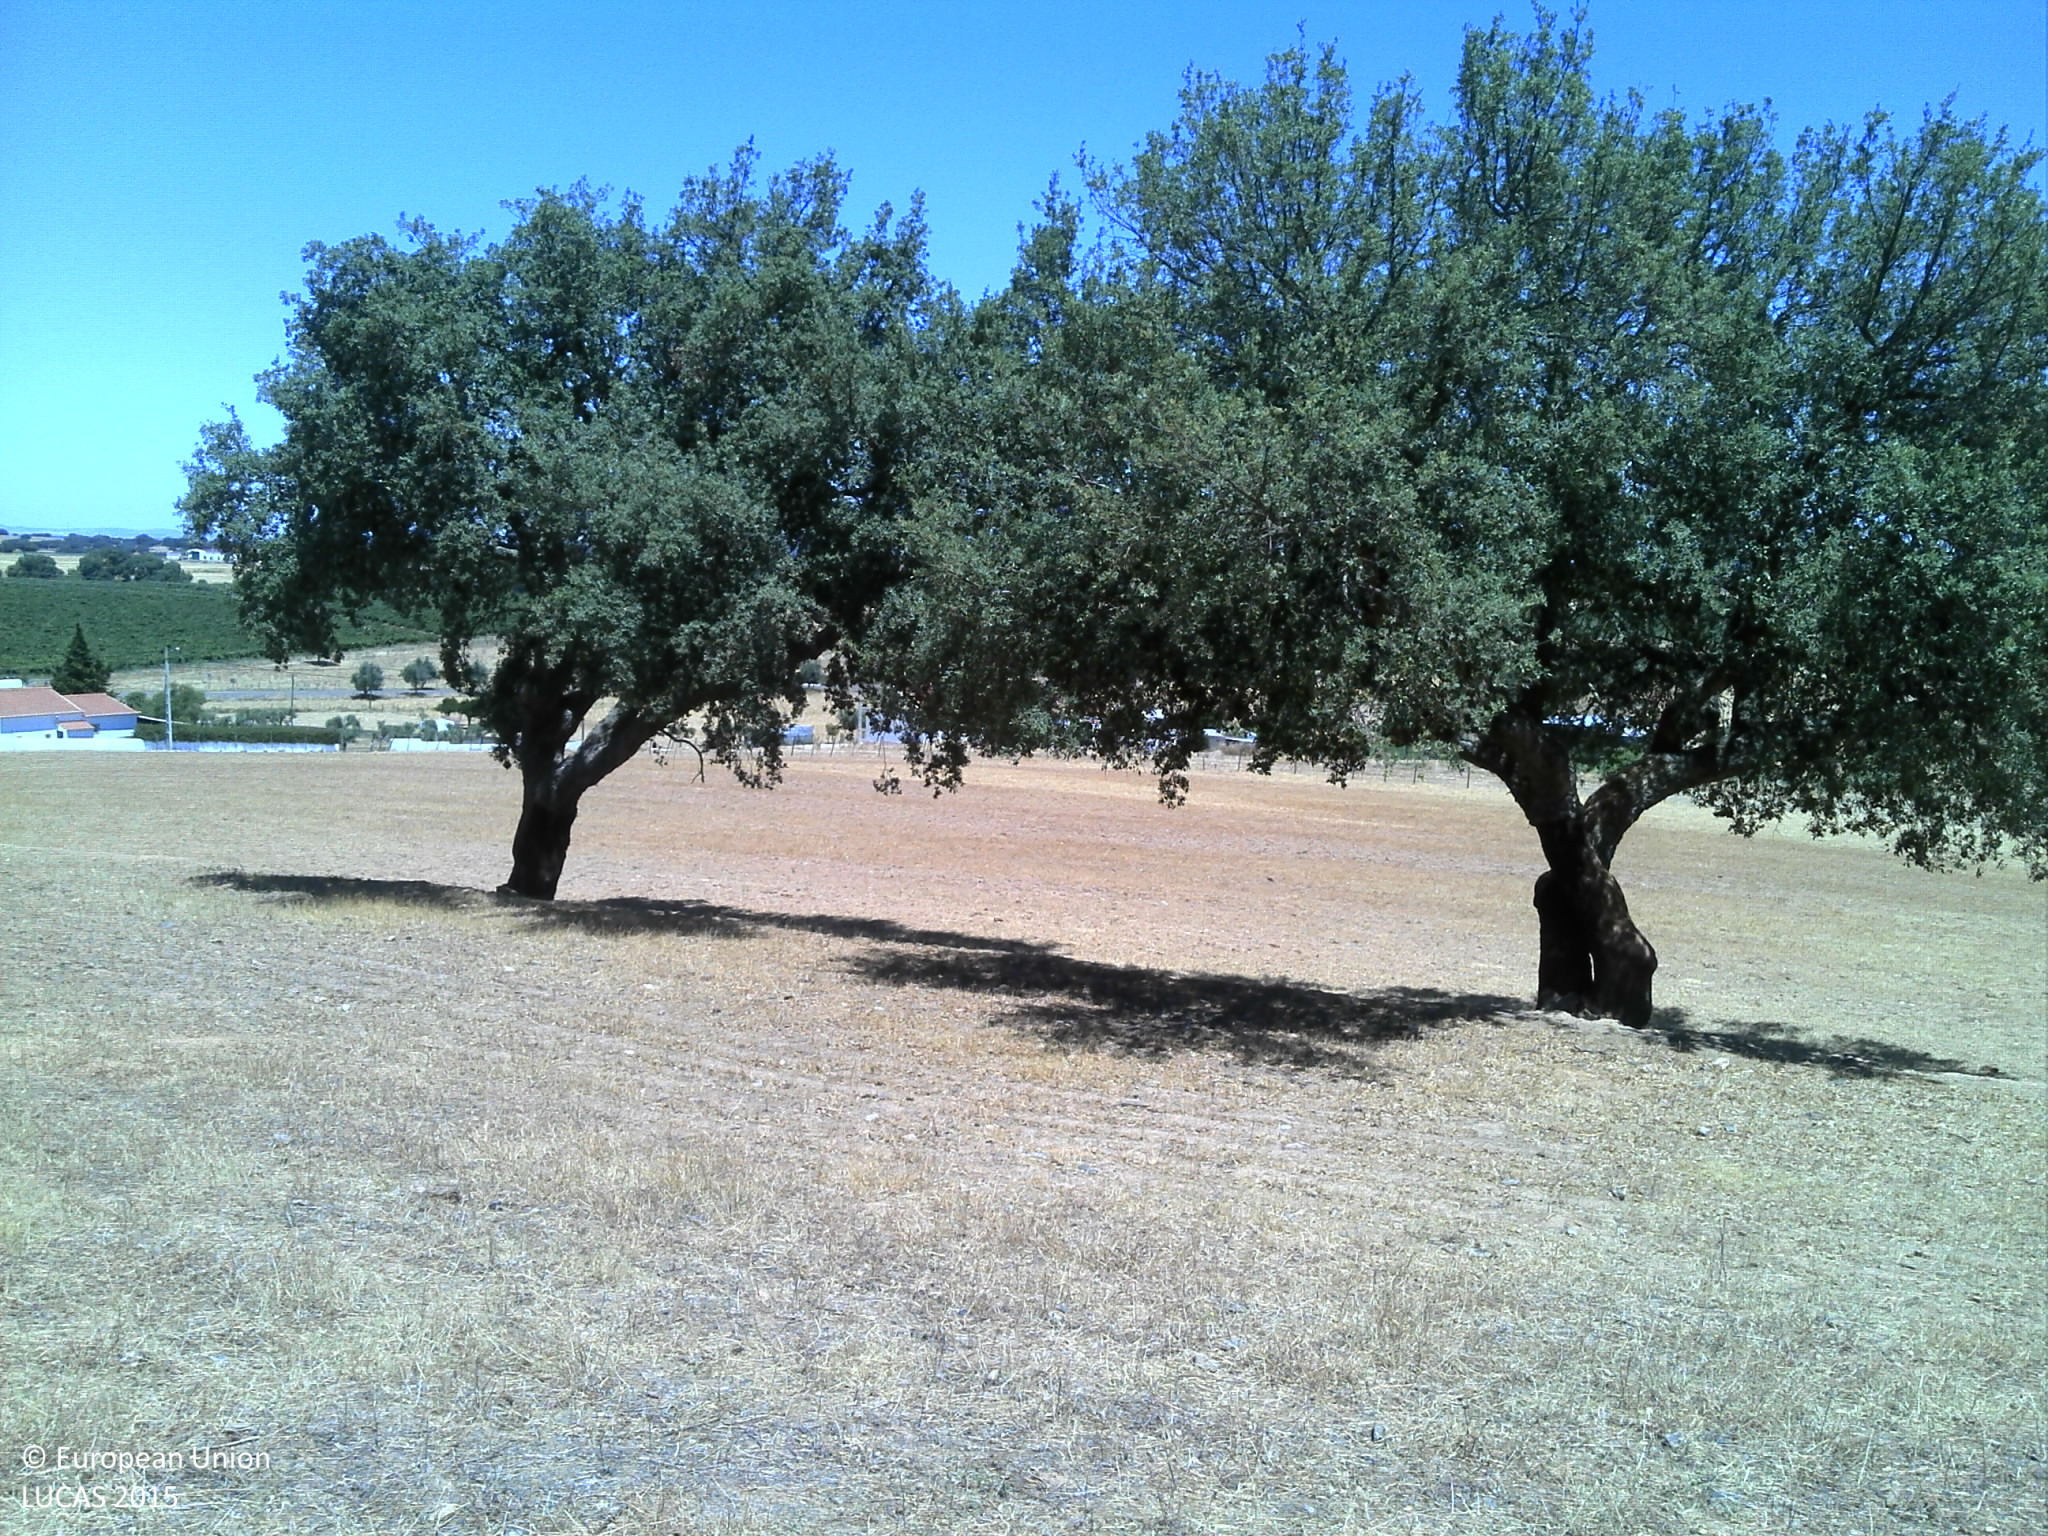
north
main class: Grassland
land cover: Grassland with sparse tree/shrub cover
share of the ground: 10 - 25 %
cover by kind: unconsolidated bare surface 70 %, herbaceous plants 25 %, broadleaved forest trees 5 %
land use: Agriculture (excluding fallow land and kitchen gardens)
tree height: > 5 m
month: July
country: PT
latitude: 38.8660
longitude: -7.4956
